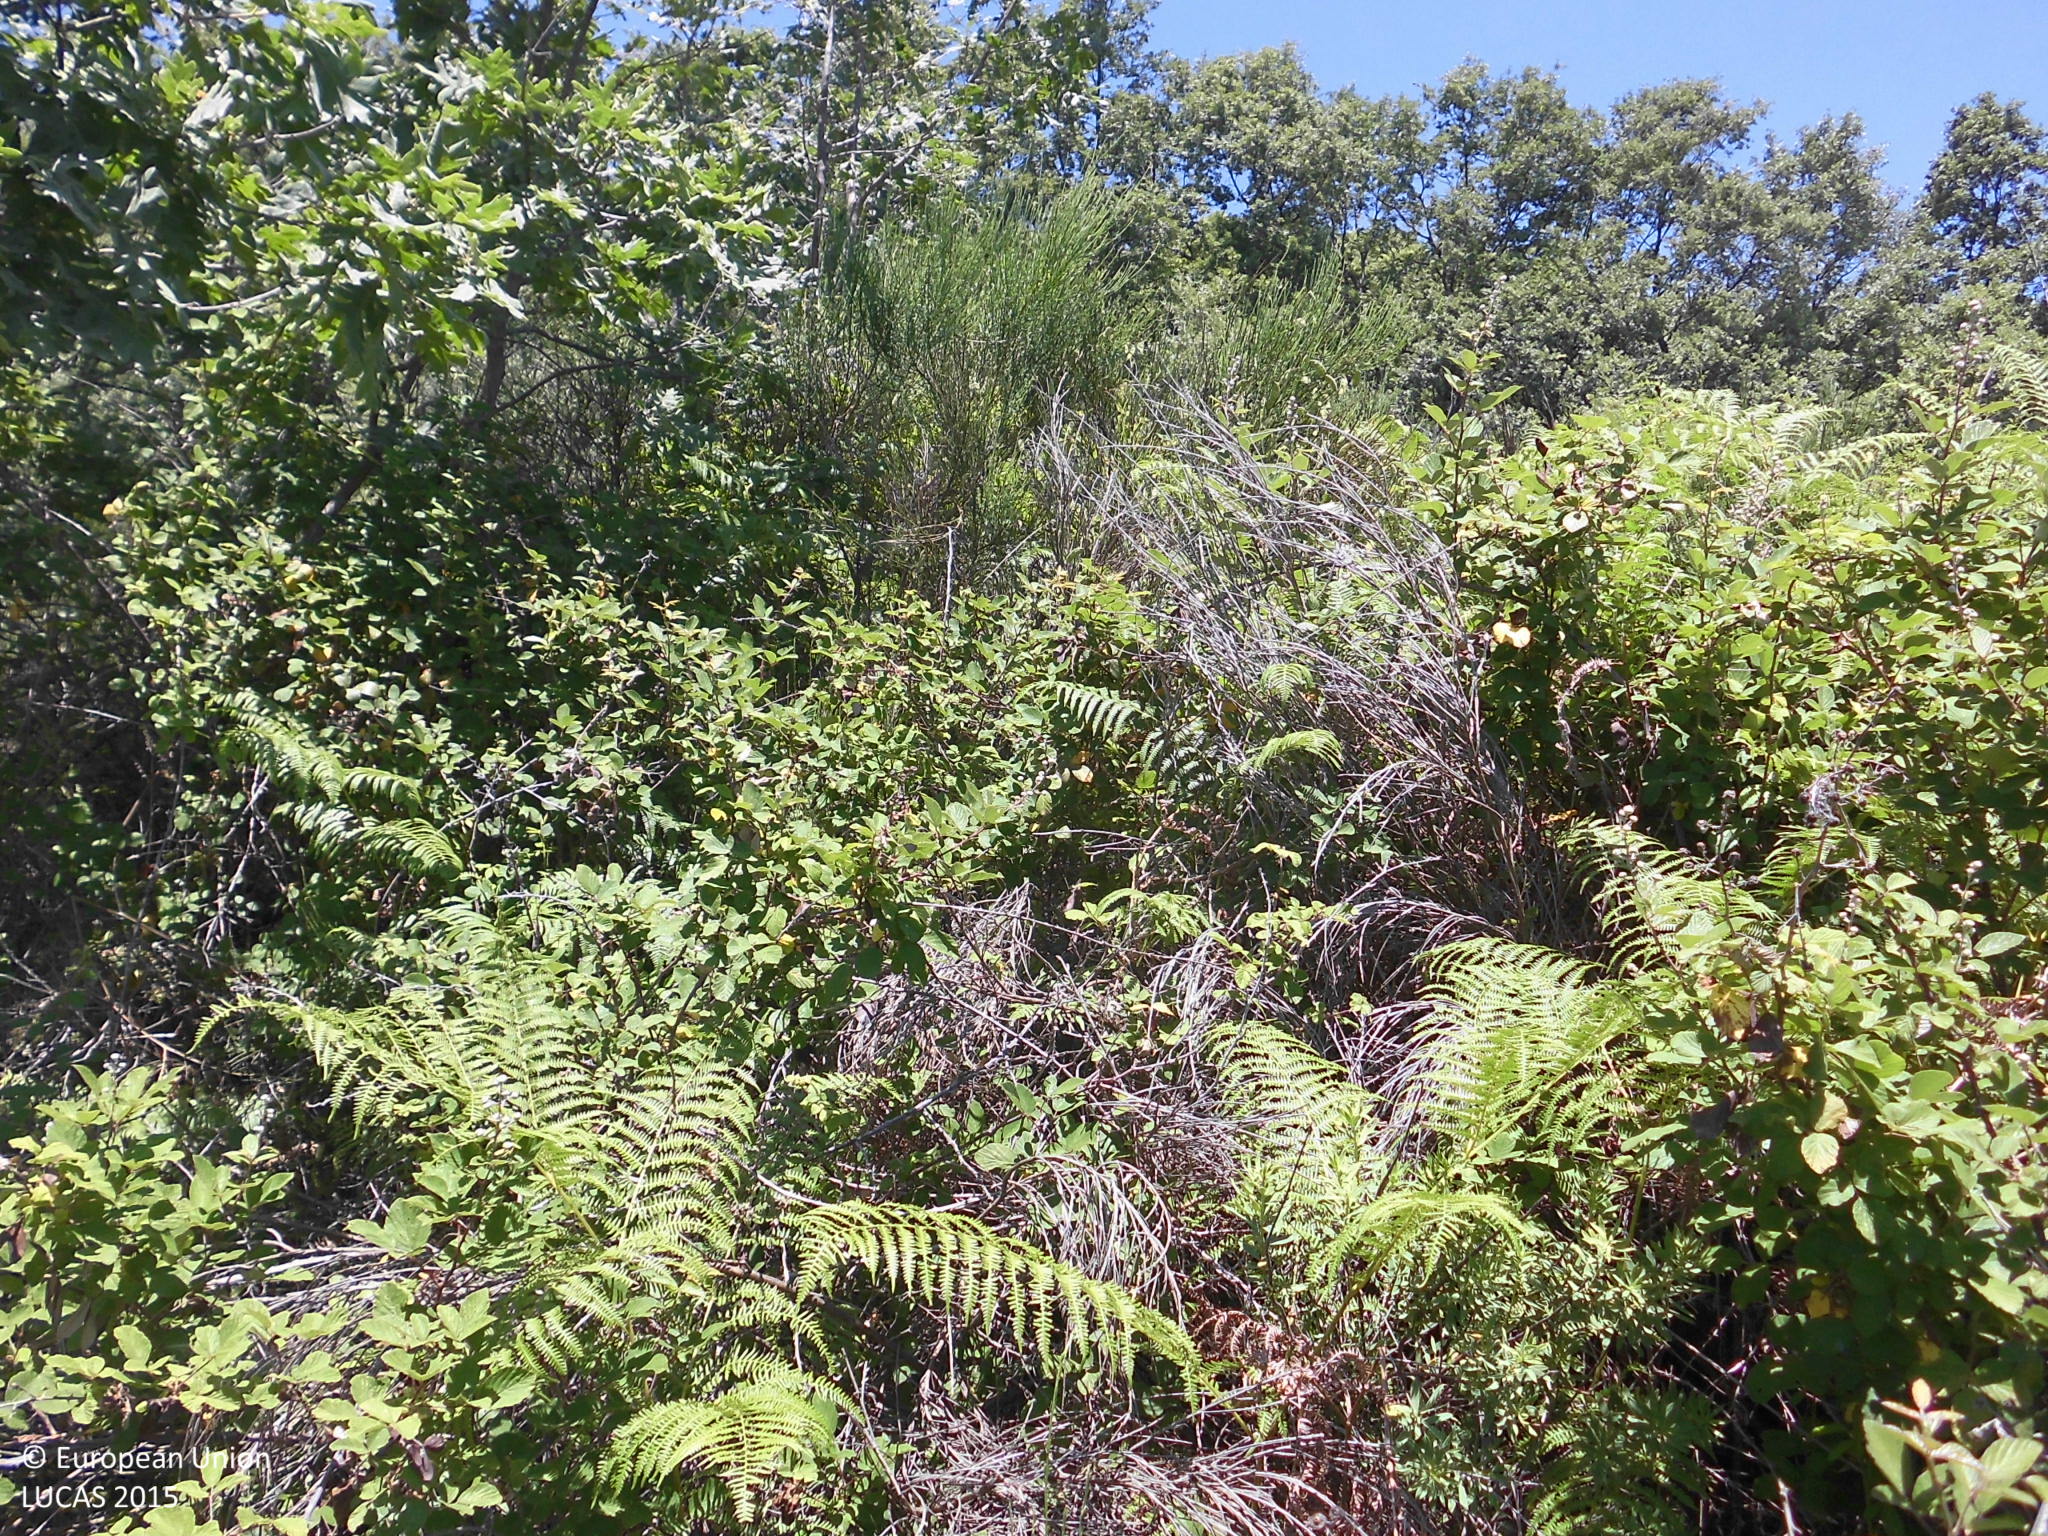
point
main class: Woodland
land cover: Broadleaved woodland
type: thermophilous deciduous forest
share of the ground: 10 - 25 %
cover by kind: shrubs 90 %, broadleaved forest trees 10 %
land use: Forestry
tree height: > 5 m
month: June
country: ES
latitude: 40.1309
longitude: -5.4942
